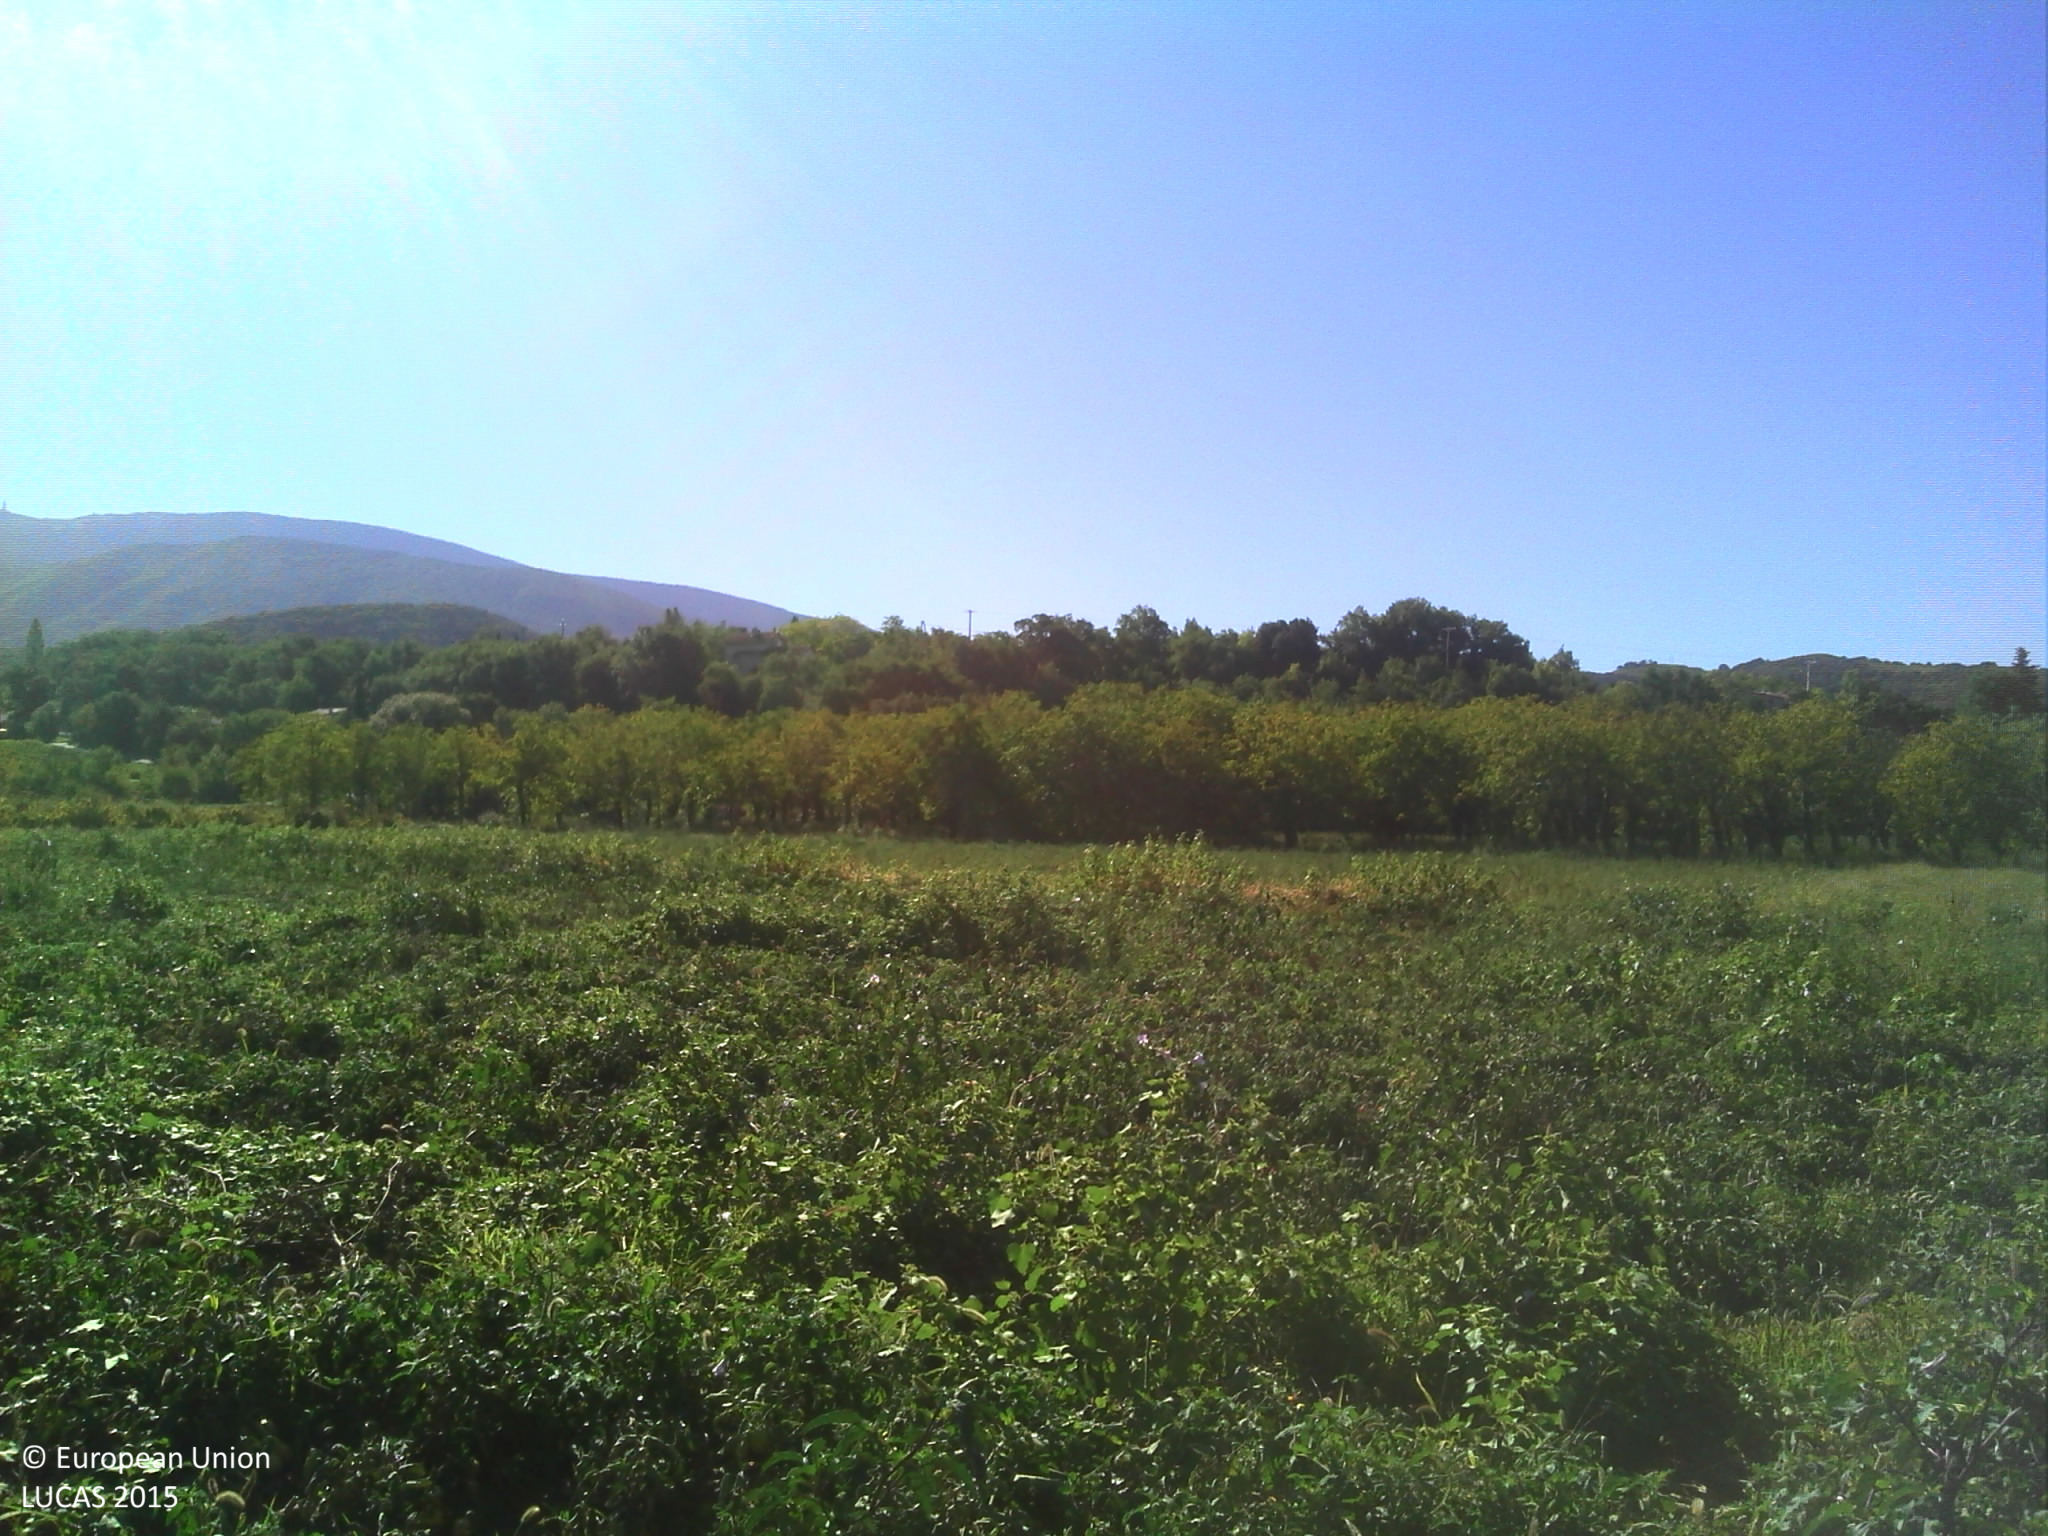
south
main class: Cropland
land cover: Tomatoes
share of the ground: > 75 %
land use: Agriculture (excluding fallow land and kitchen gardens)
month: September
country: FR
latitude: 44.2377
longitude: 5.1621
